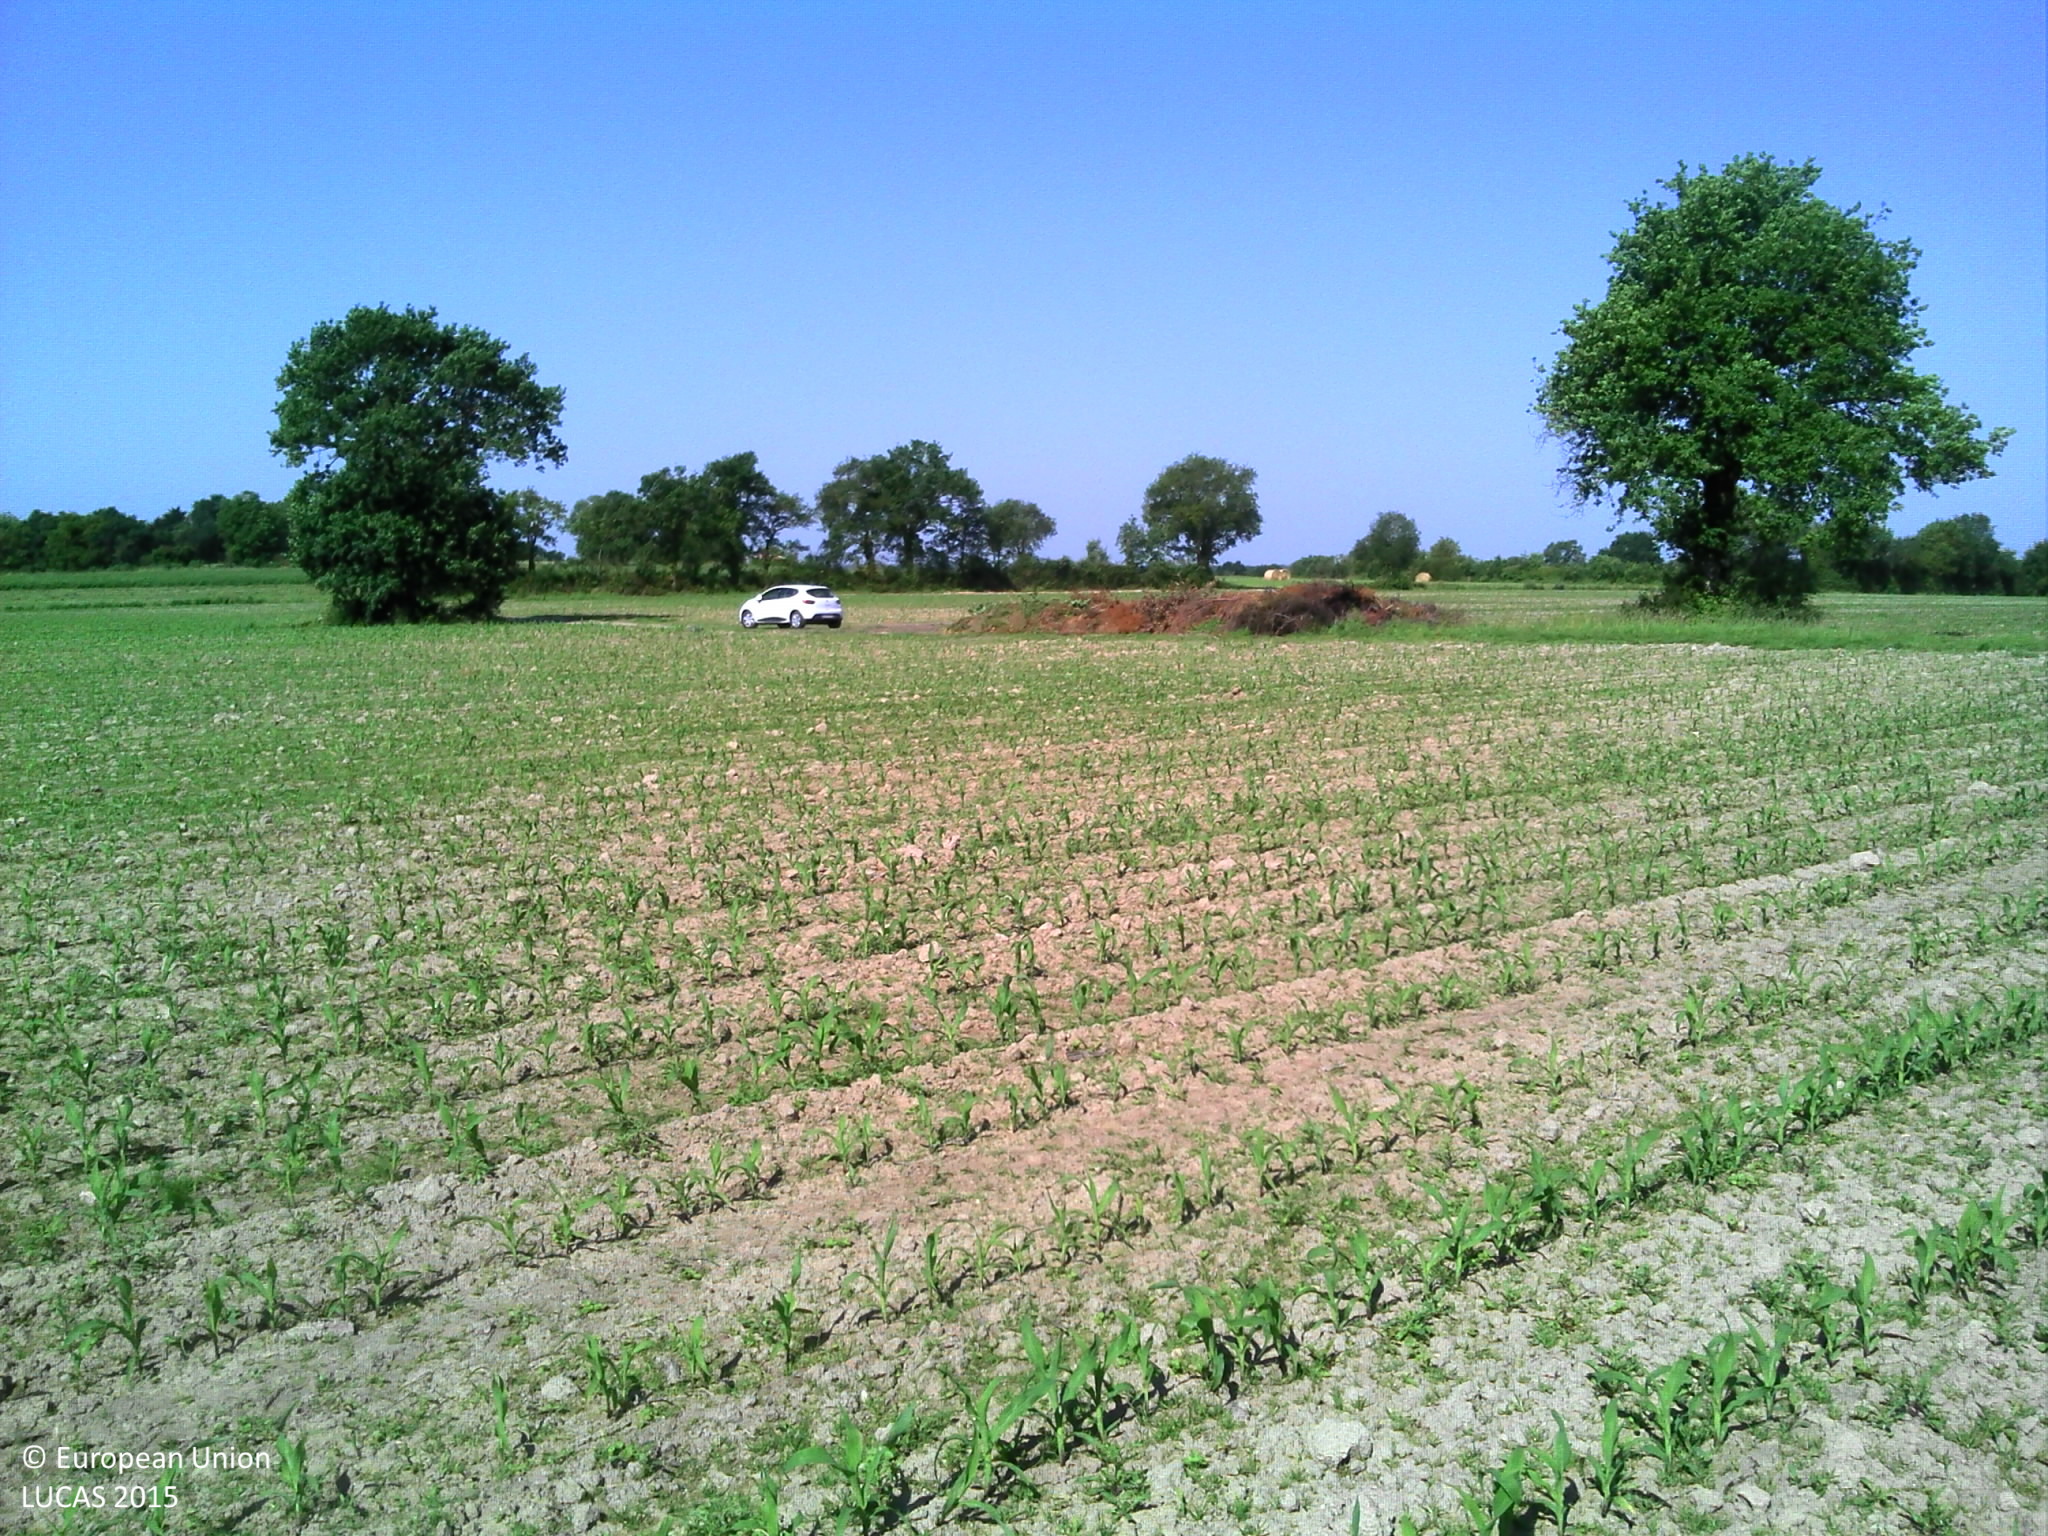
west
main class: Cropland
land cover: Maize
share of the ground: 10 - 25 %
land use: Agriculture (excluding fallow land and kitchen gardens)
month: June
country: FR
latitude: 47.0678
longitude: -1.2166
